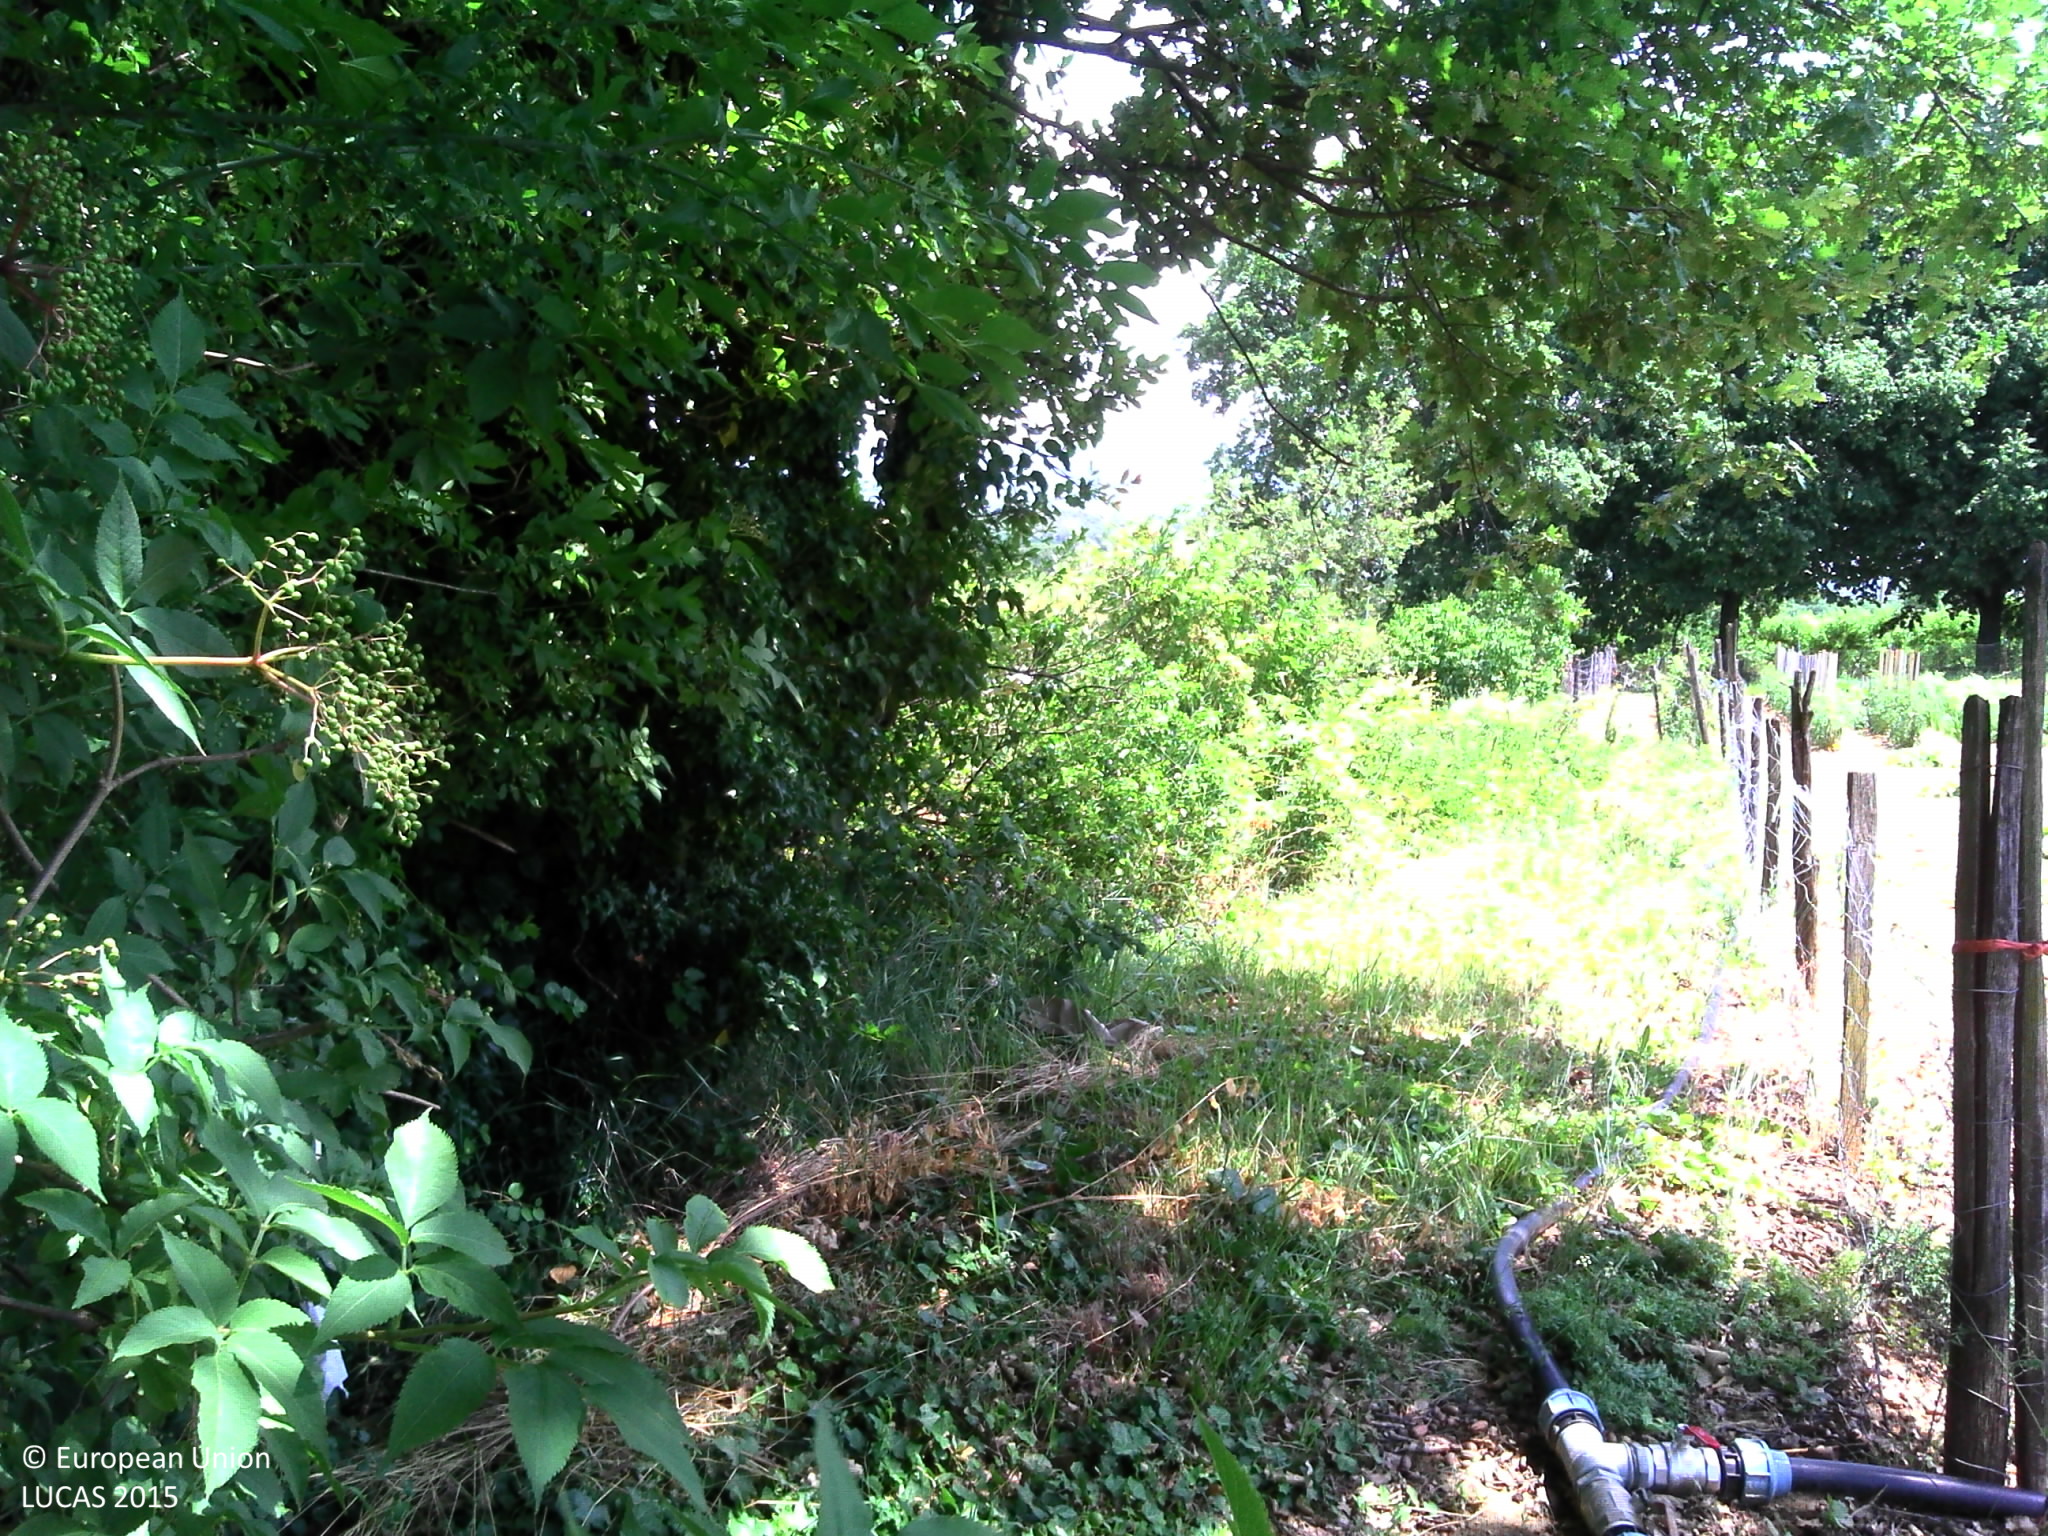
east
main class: Woodland
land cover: Broadleaved woodland
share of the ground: > 75 %
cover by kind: broadleaved forest trees 95 %, herbaceous plants 5 %
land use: Semi-natural and natural areas not in use
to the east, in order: Broadleaved woodland; Paved roads, cycling and walking lanes; Abandoned hedges; Sunflower; Tracks; Other fruit trees and berries; Electric lines; Other fruit trees and berries; Other bare soil
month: June
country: FR
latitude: 44.8410
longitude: 4.9330
